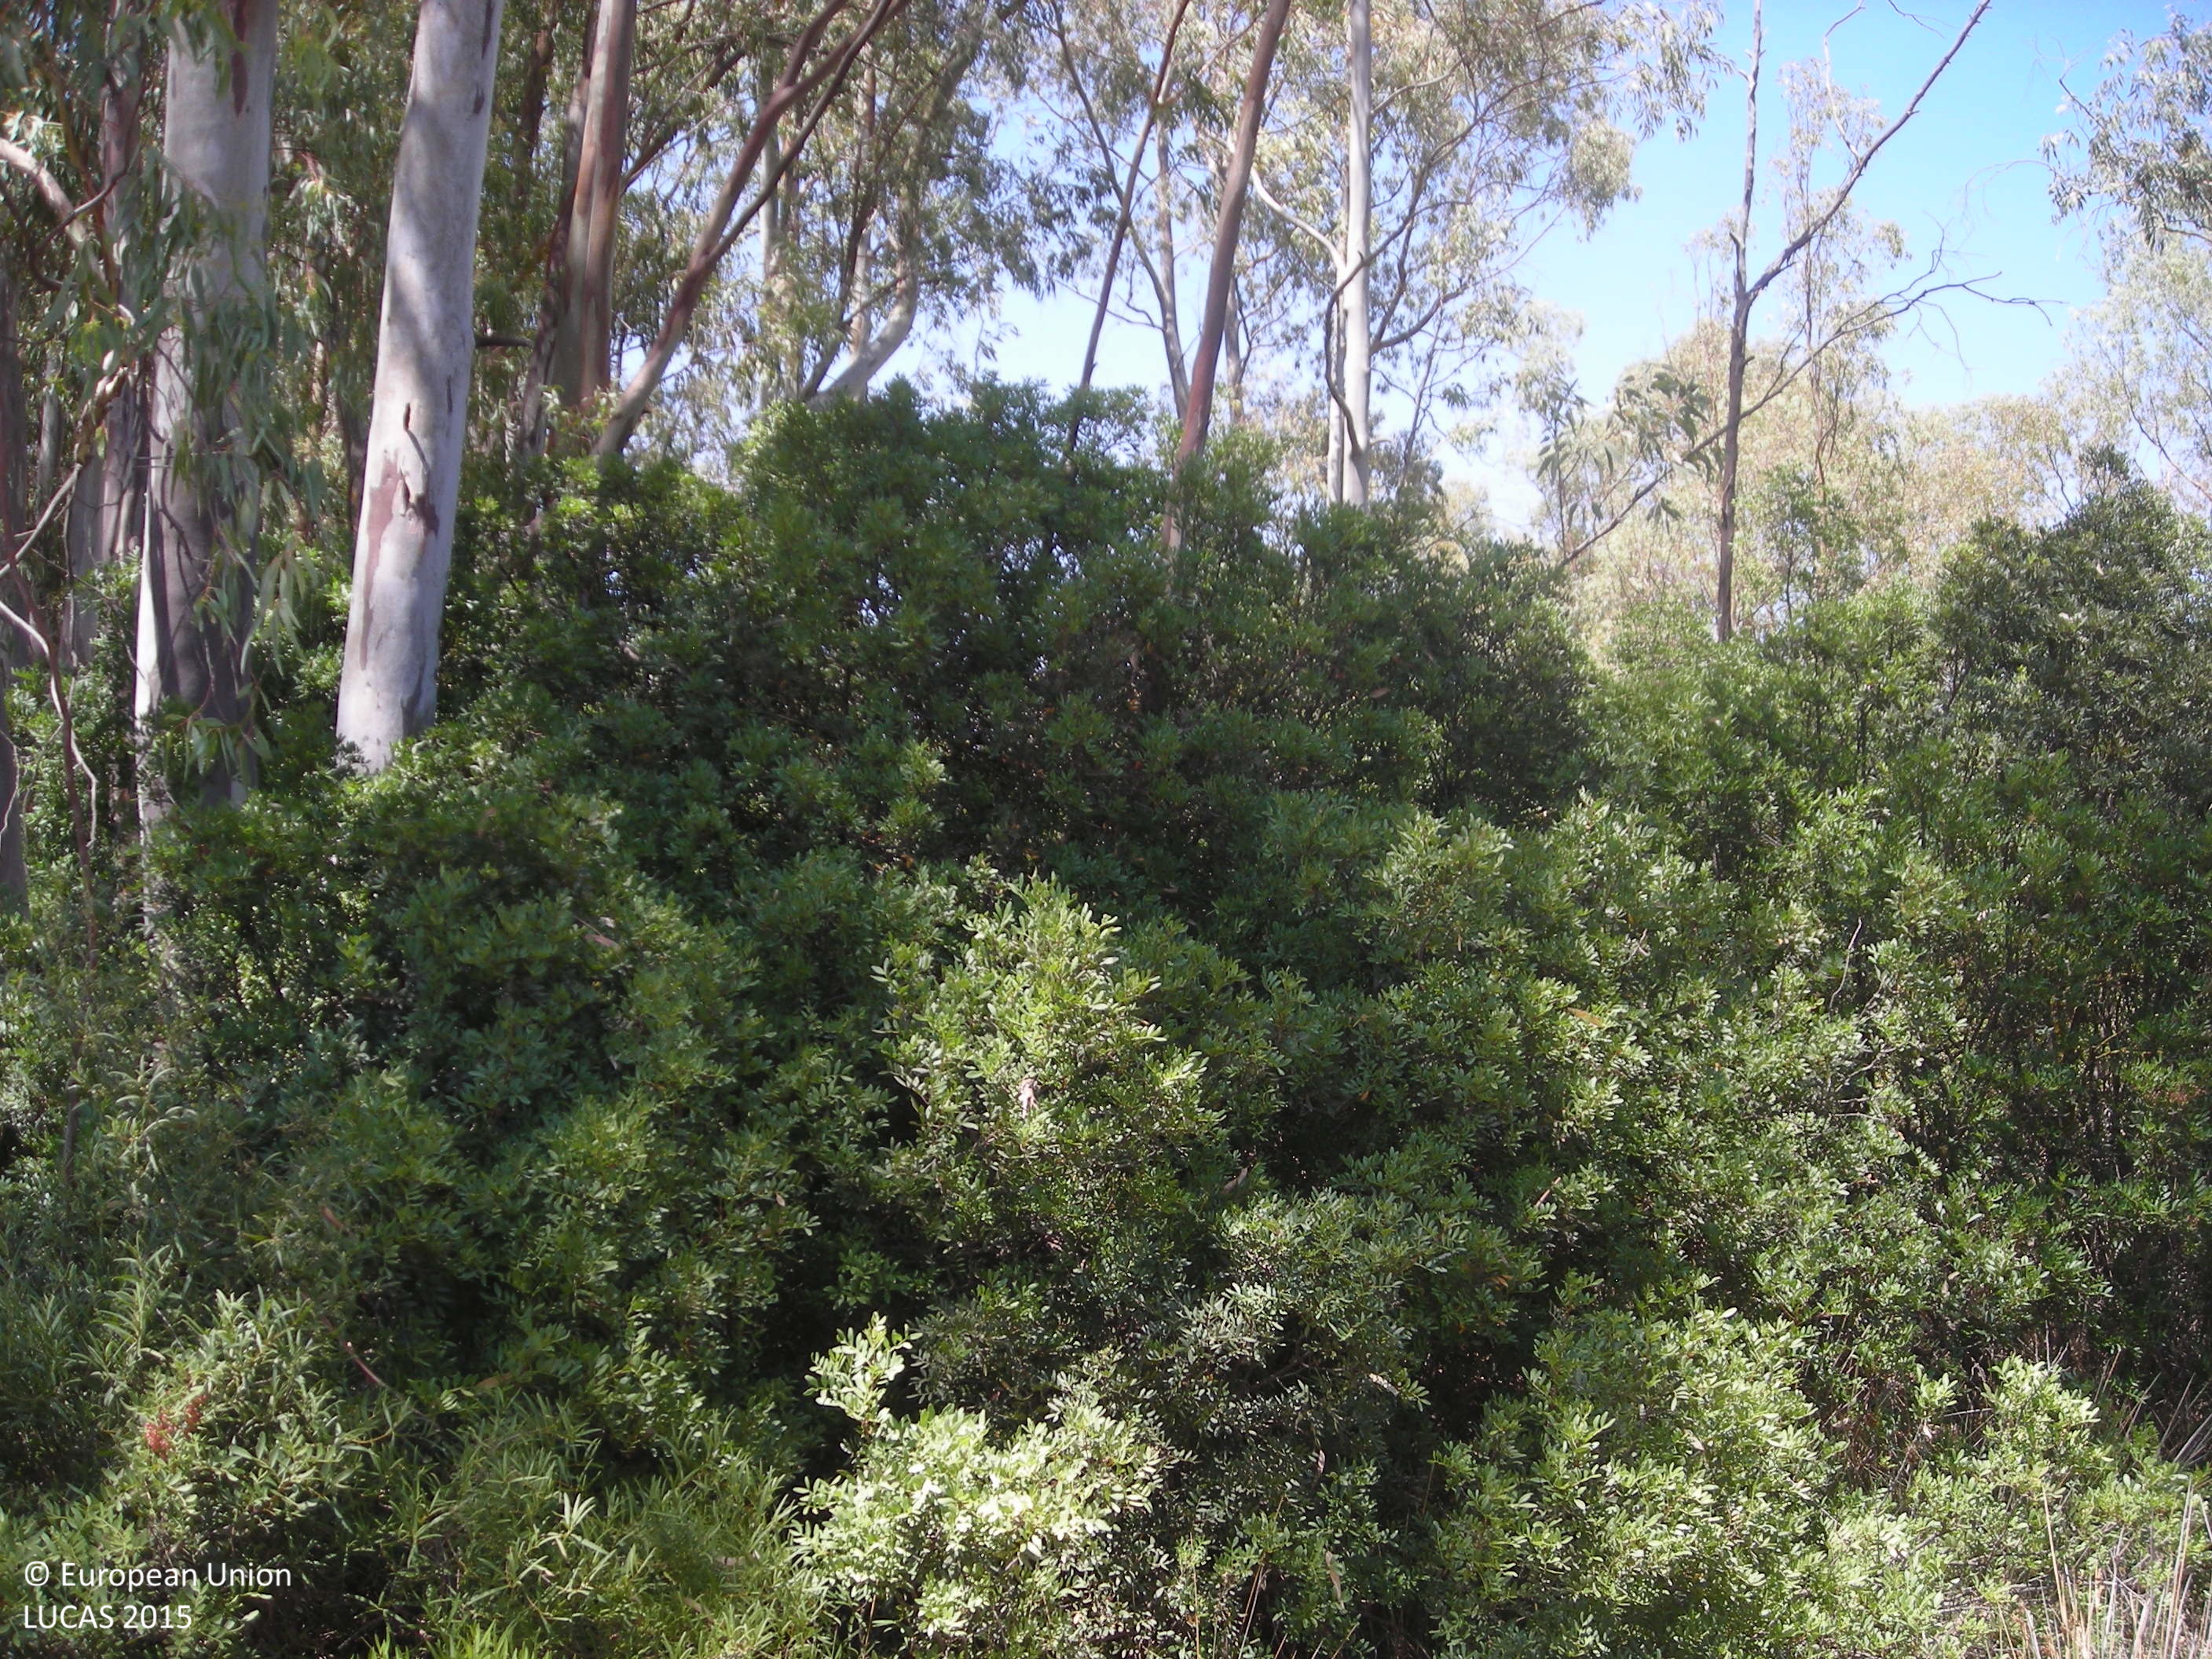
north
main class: Shrubland
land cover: Shrubland without tree cover
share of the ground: > 75 %
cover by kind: shrubs 100 %
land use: Semi-natural and natural areas not in use
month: July
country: ES
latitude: 38.7574
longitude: -5.7986
